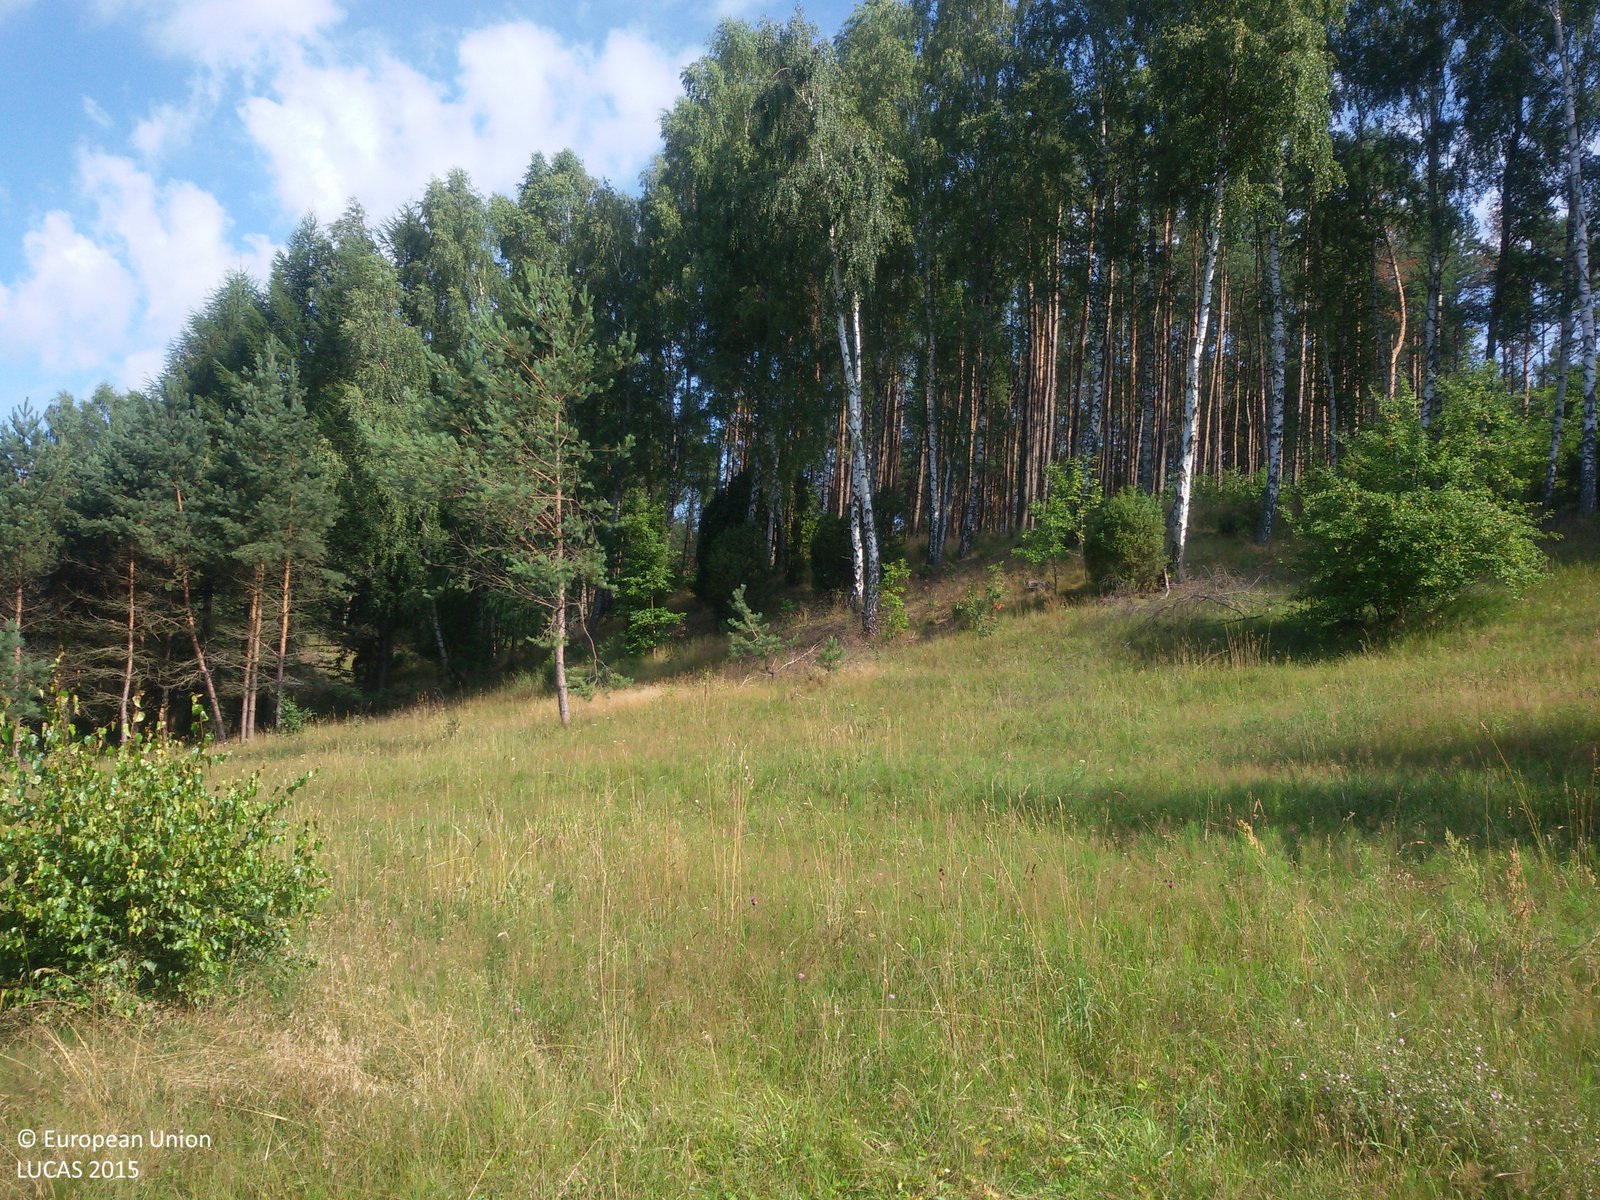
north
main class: Woodland
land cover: Pine dominated mixed woodland
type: hemiboreal forest and nemoral coniferous forest and mixed broadleaved-coniferous forest
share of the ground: > 75 %
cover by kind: coniferous forest trees 50 %, broadleaved forest trees 35 %, shrubs 10 %, herbaceous plants 5 %
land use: Forestry
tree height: > 5 m
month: August
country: PL
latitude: 54.2128
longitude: 17.8486
